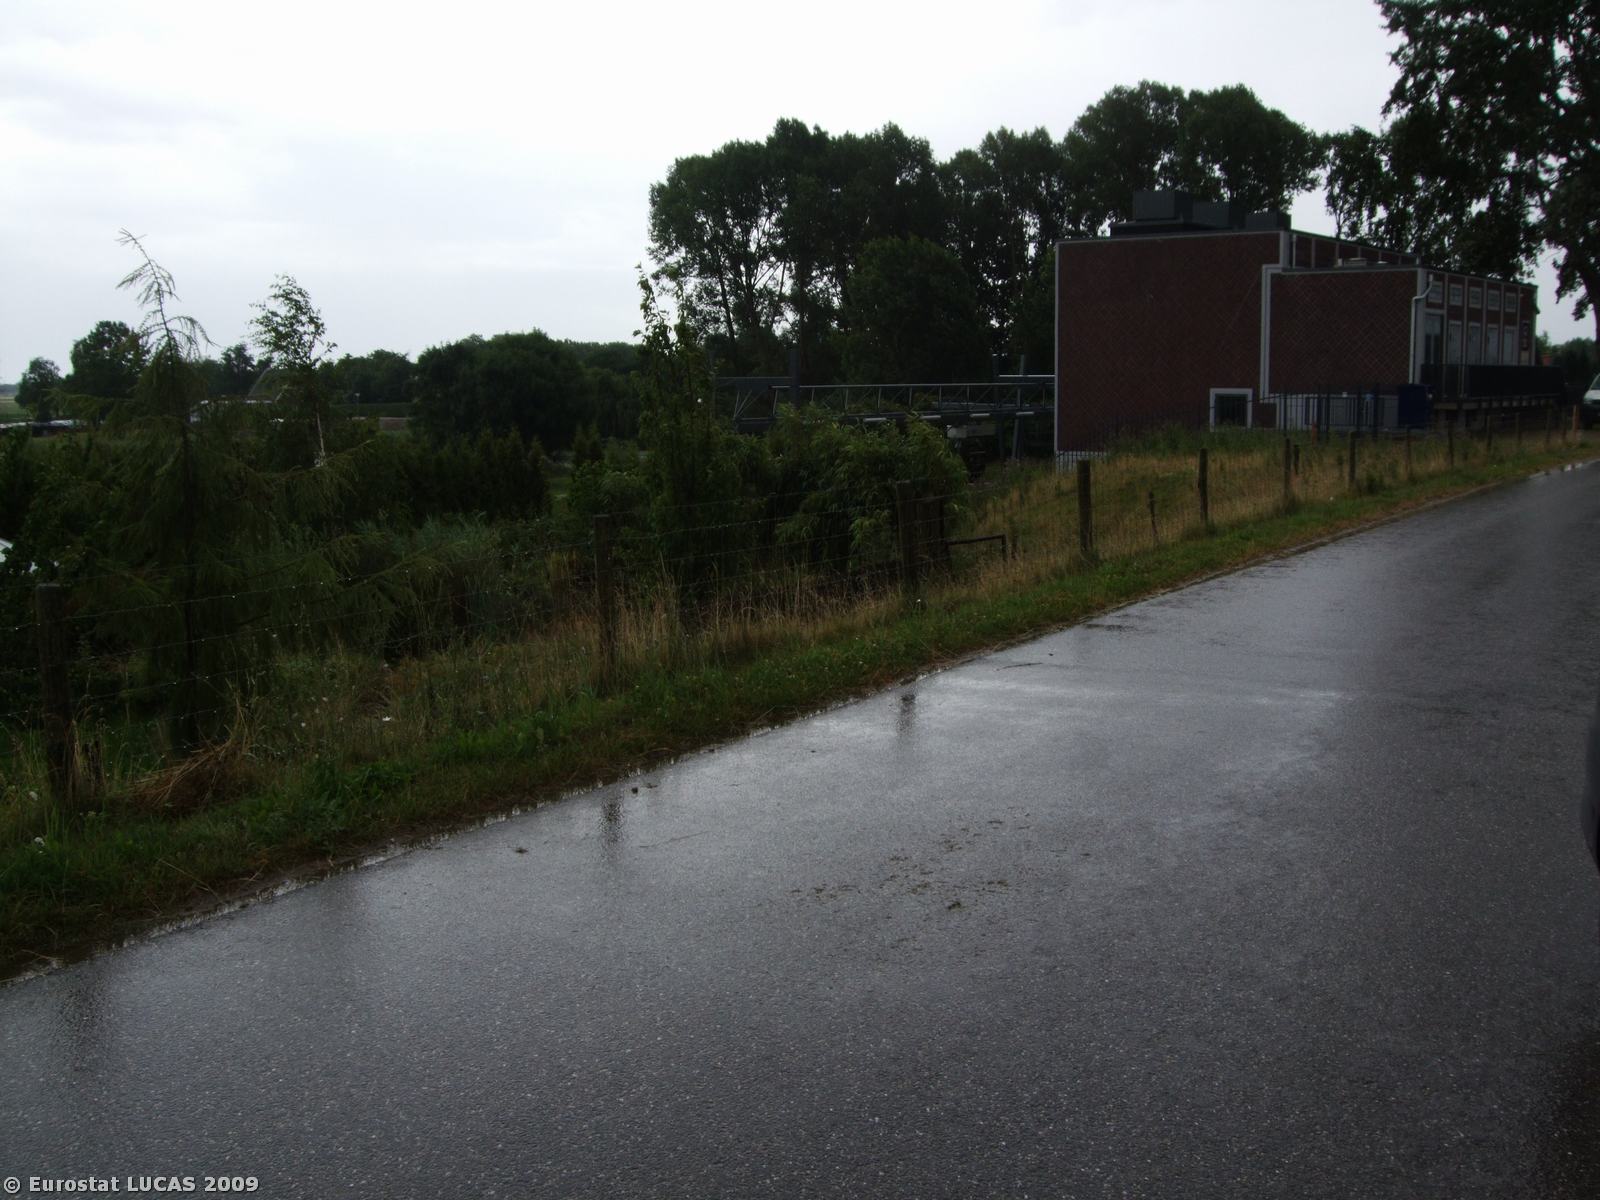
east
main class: Cropland
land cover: Maize
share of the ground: > 75 %
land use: Agriculture (excluding fallow land and kitchen gardens)
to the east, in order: Maize; Fences; Grassland without tree/shrub cover; Paved roads, cycling and walking lanes; Artificial constructions in urban areas; Inland running water
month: July
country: NL
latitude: 51.8214
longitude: 5.4281
